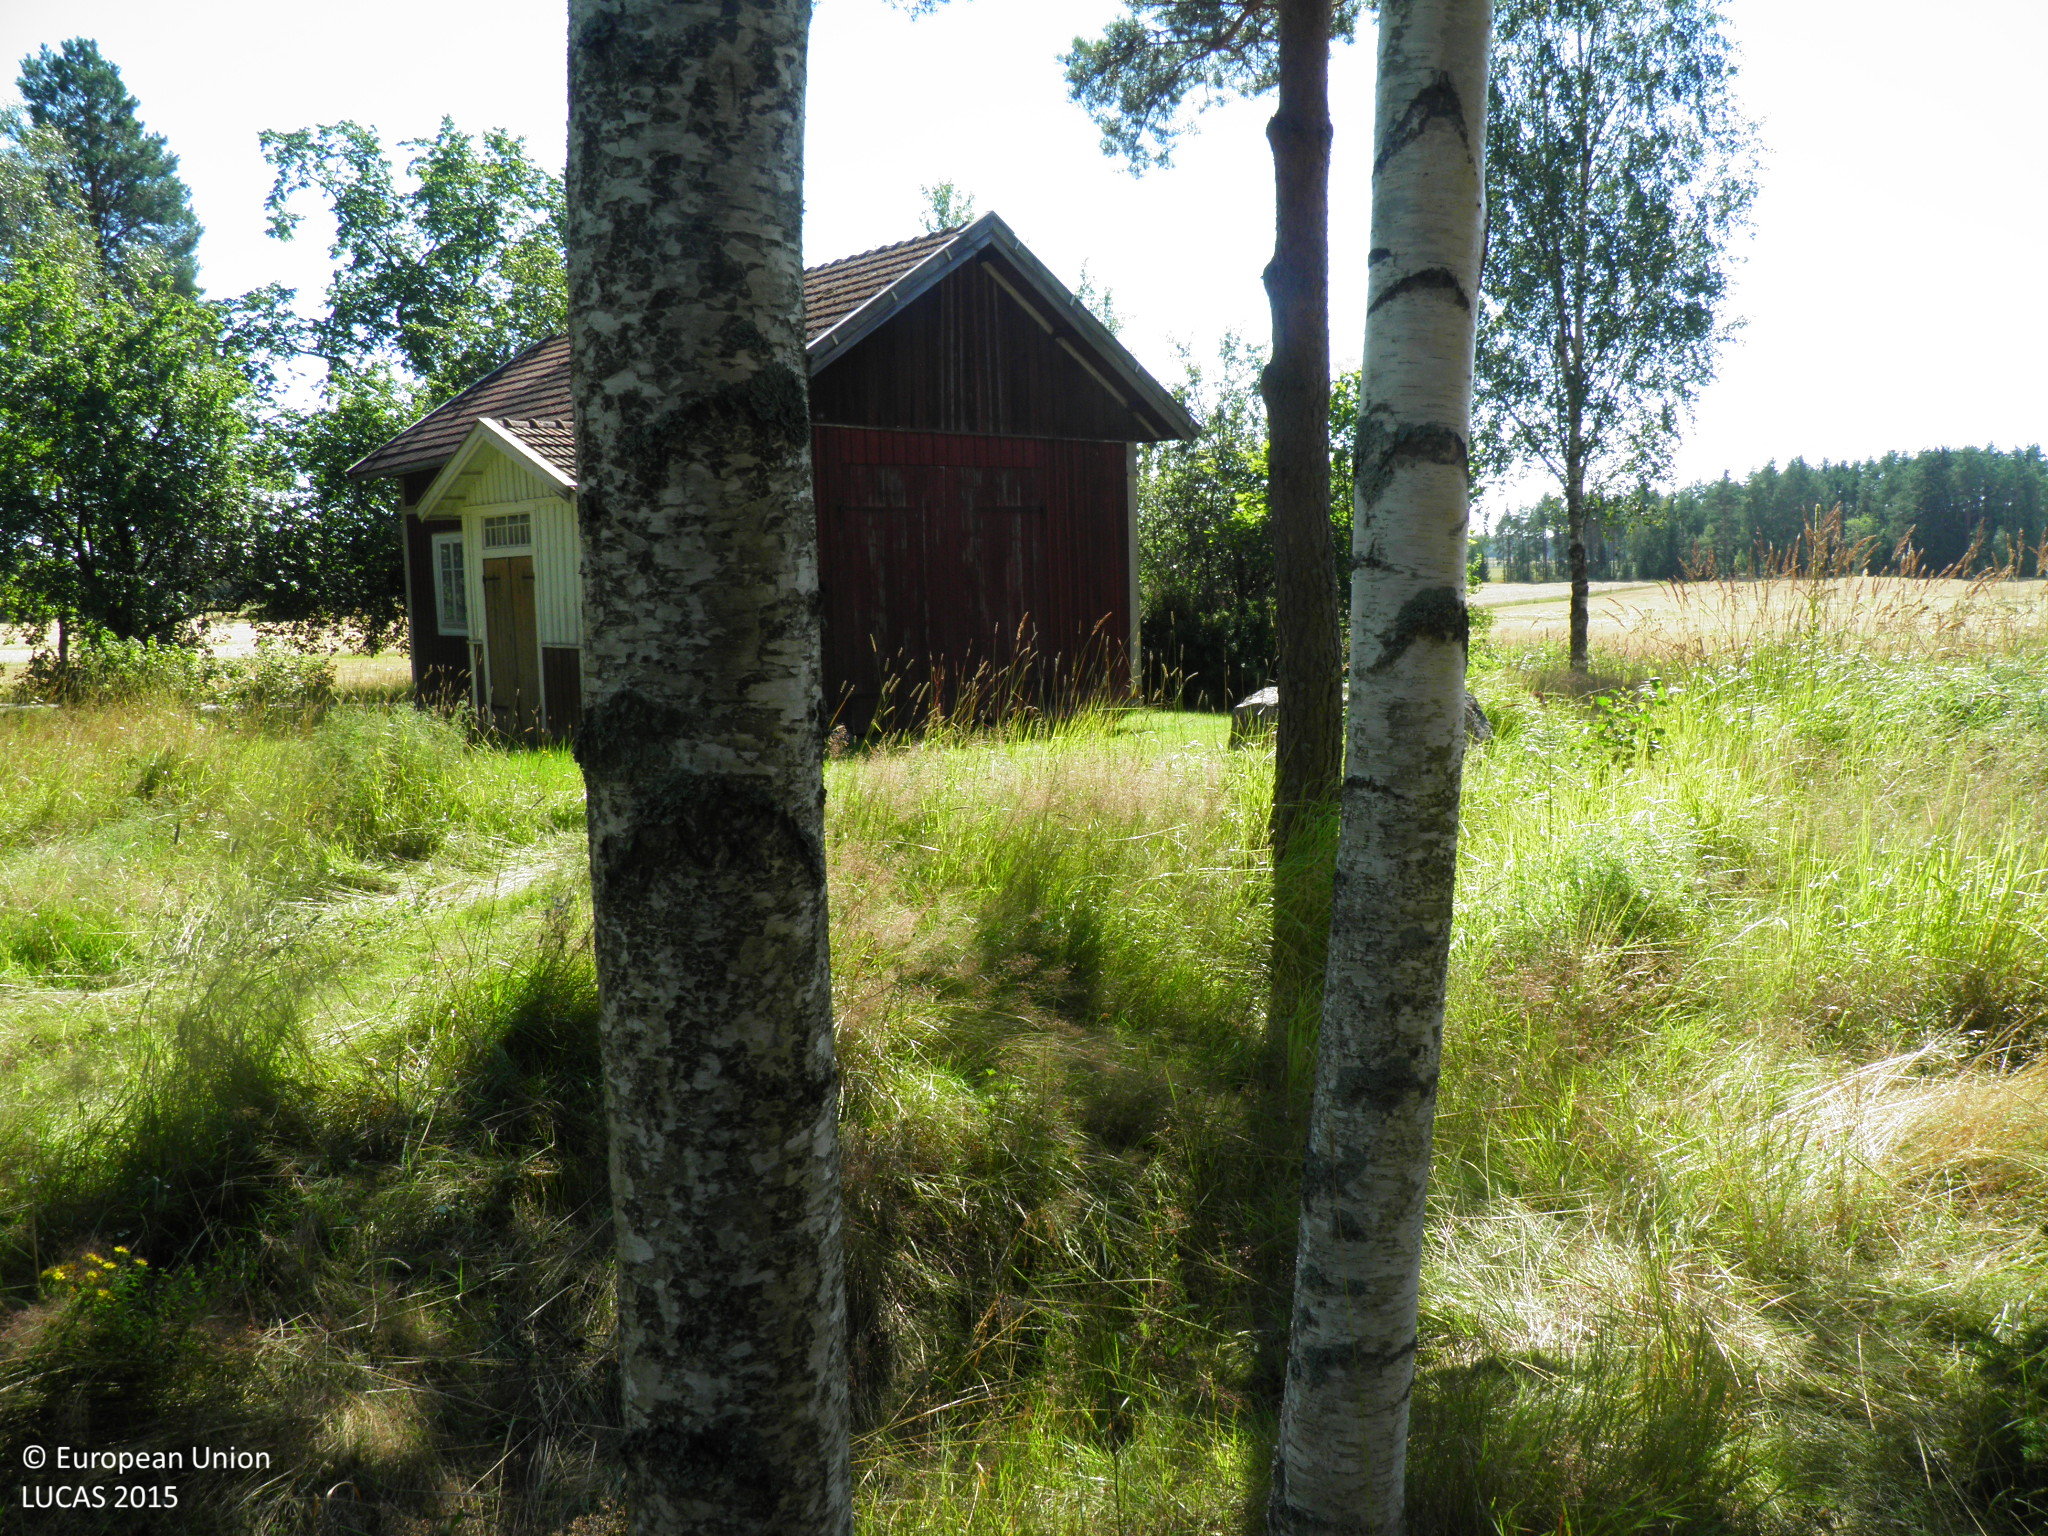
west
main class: Woodland
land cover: Pine dominated mixed woodland
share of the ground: 50 - 75 %
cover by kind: coniferous forest trees 30 %, shrubs 25 %, herbaceous plants 25 %, broadleaved forest trees 20 %
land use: Forestry
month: August
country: FI
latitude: 60.7812
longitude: 21.5334
